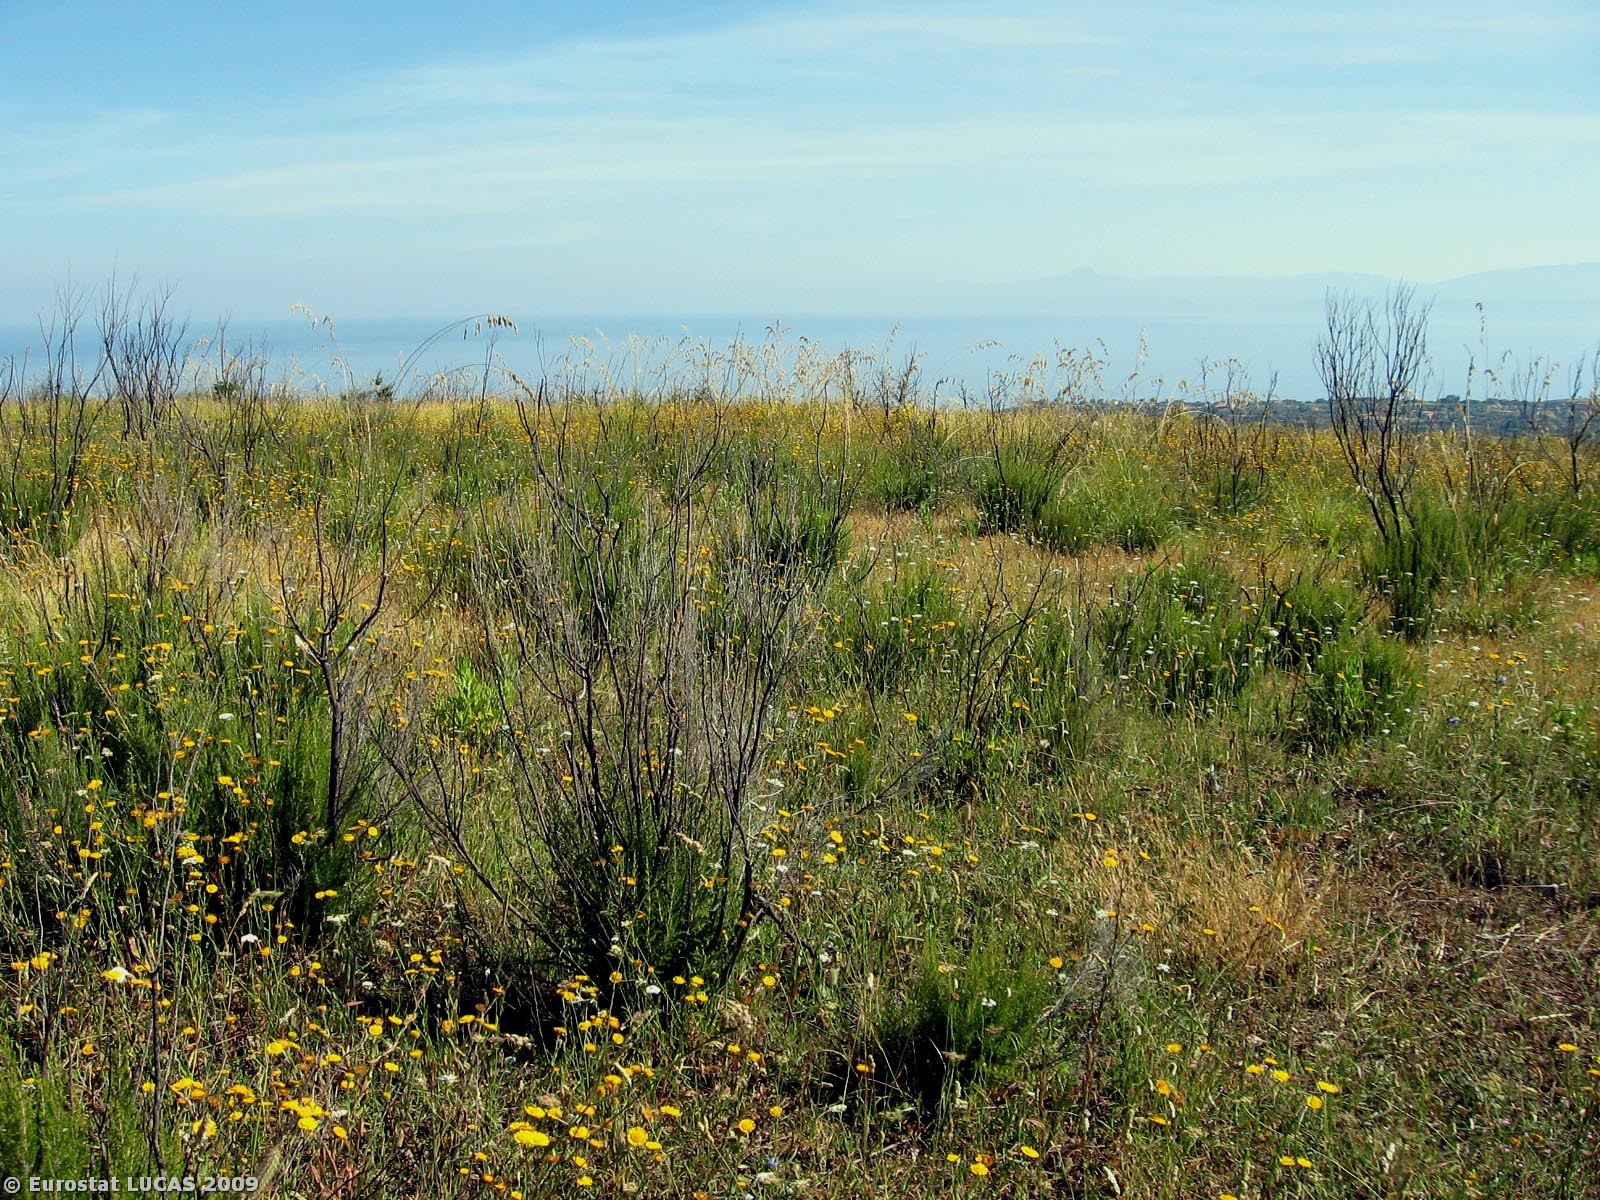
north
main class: Grassland
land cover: Grassland without tree/shrub cover
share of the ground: 50 - 75 %
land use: Fallow land
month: June
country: IT
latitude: 38.6867
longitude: 15.9789
